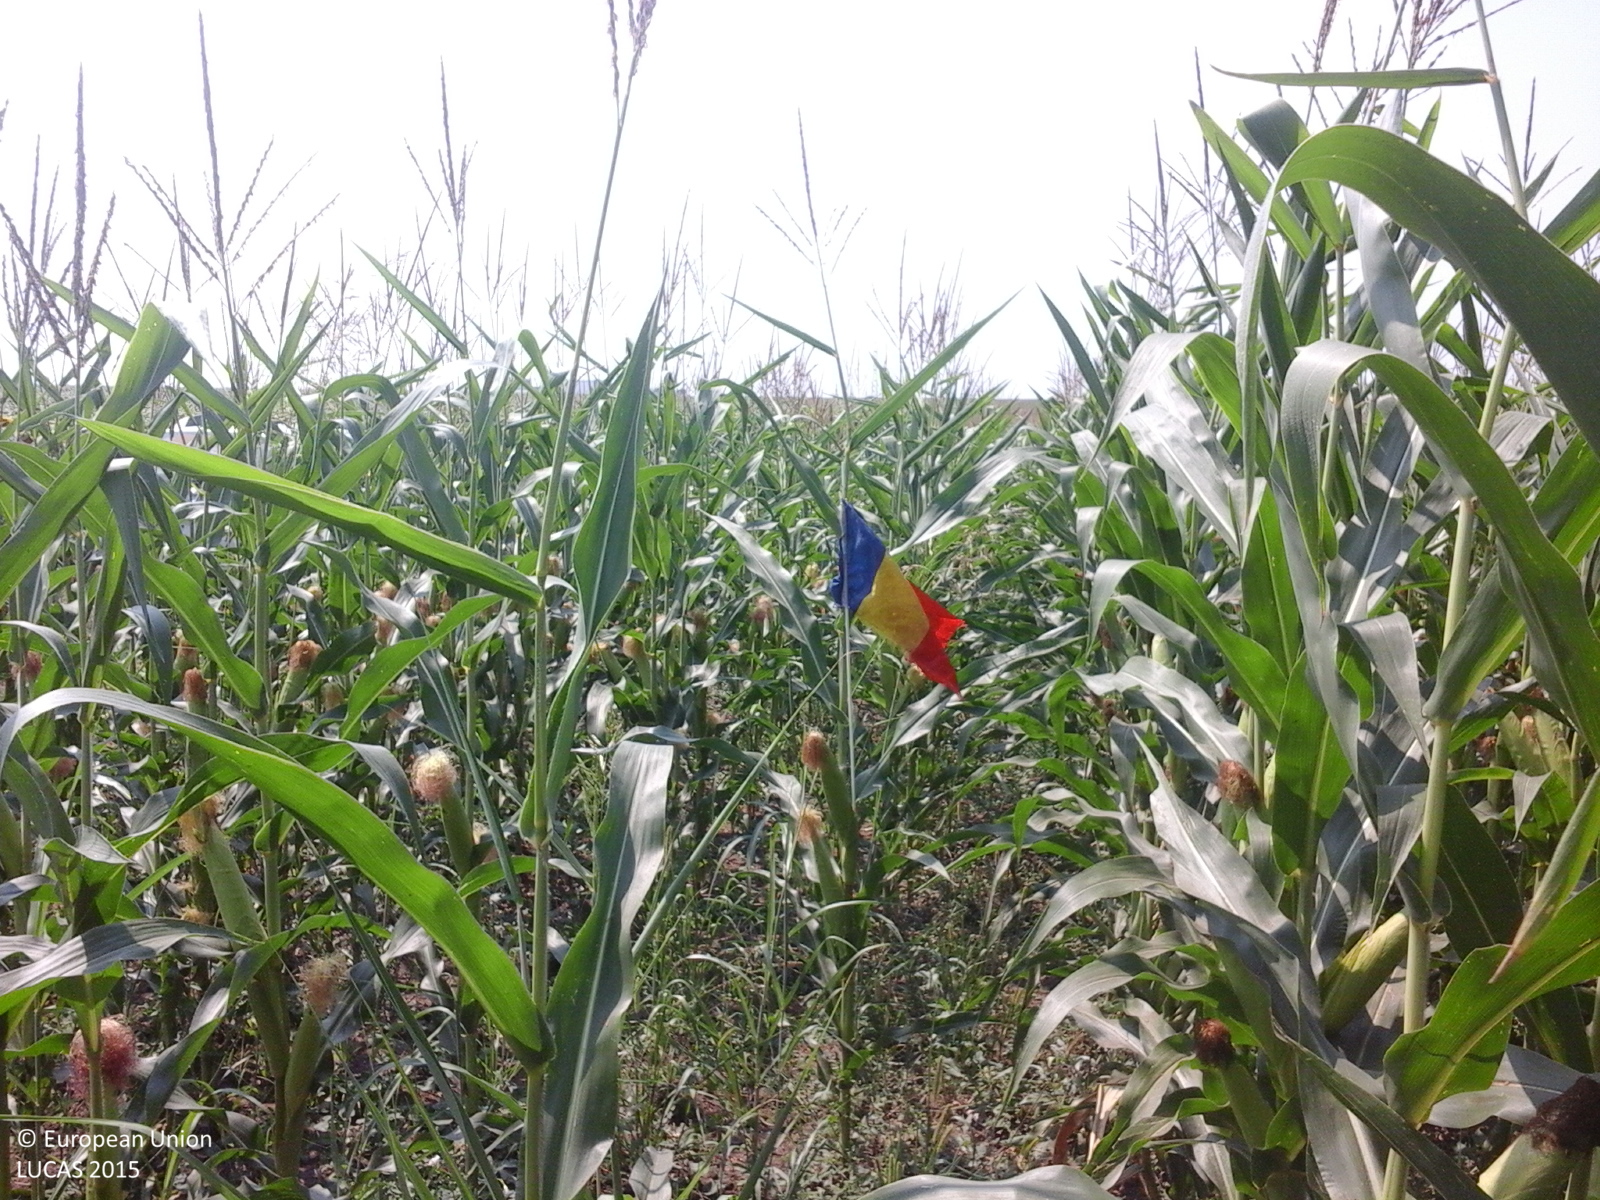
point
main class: Cropland
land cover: Maize
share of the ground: > 75 %
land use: Agriculture (excluding fallow land and kitchen gardens)
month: July
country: RO
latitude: 44.6059
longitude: 26.4576
